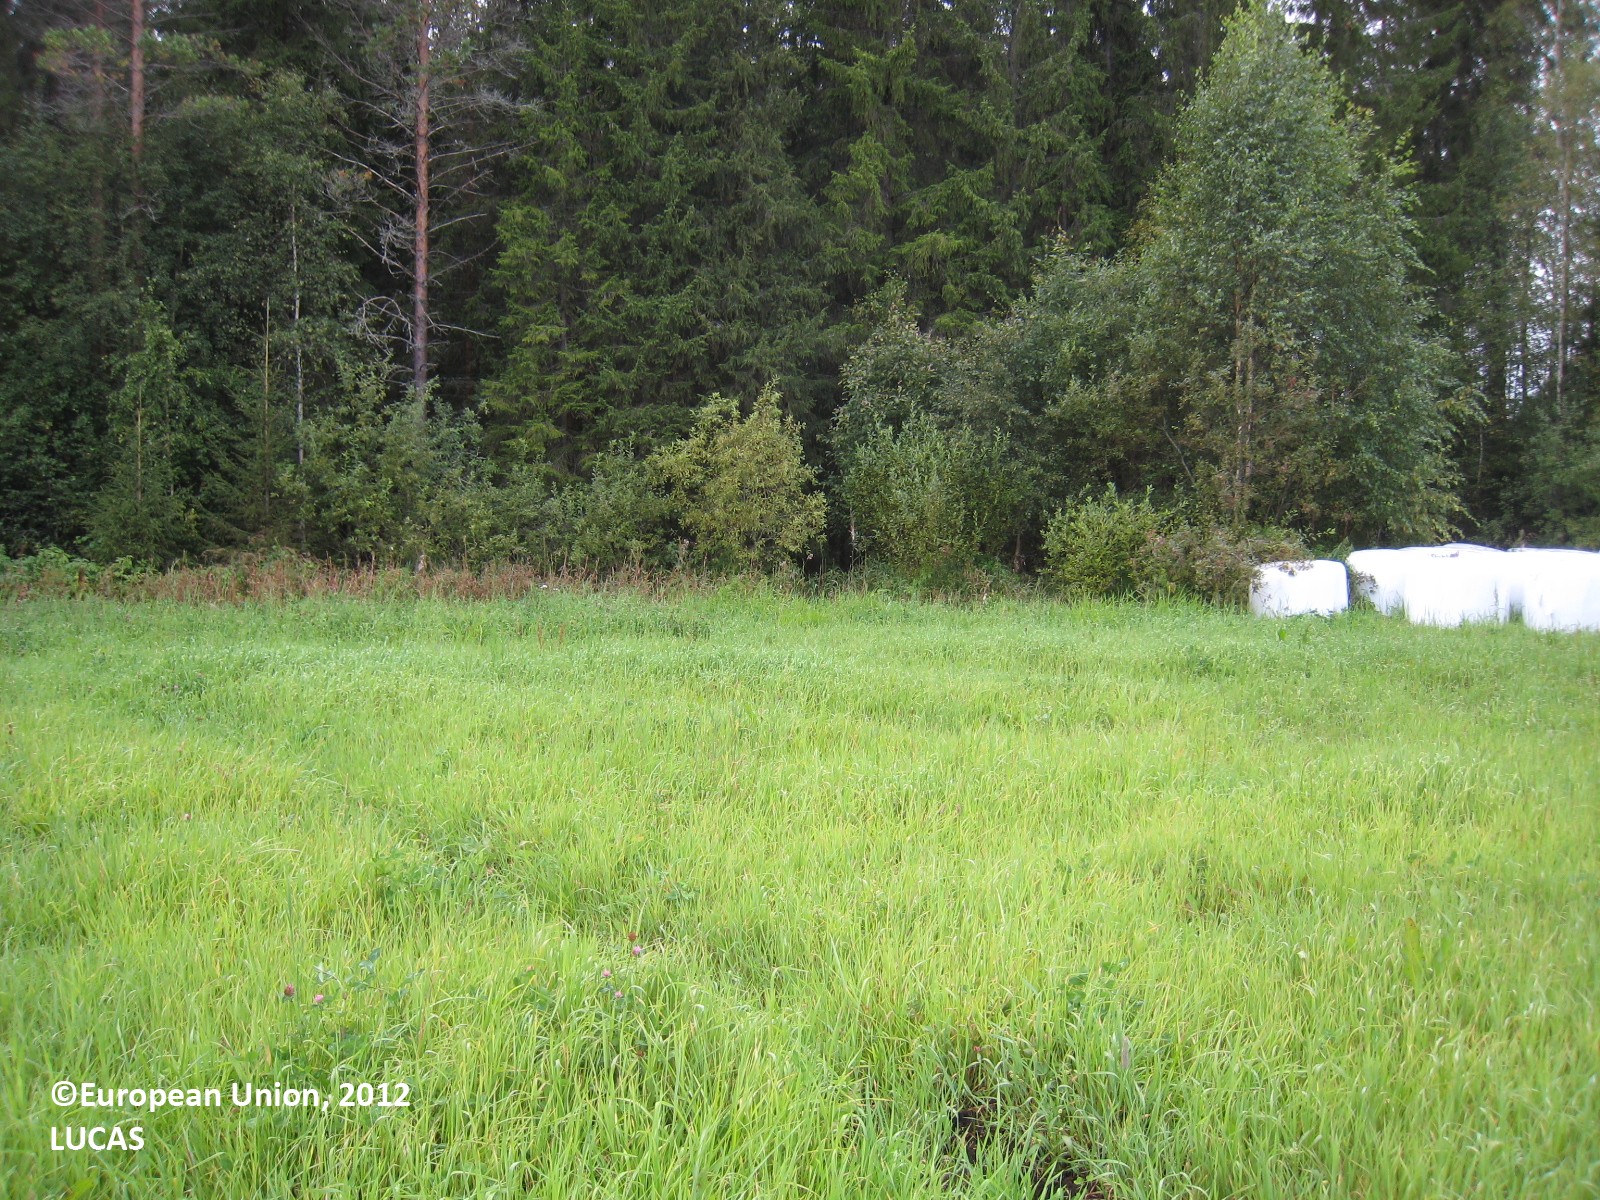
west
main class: Cropland
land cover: Temporary grasslands
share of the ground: > 75 %
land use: Agriculture (excluding fallow land and kitchen gardens)
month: August
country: FI
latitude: 61.8775
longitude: 26.1664
